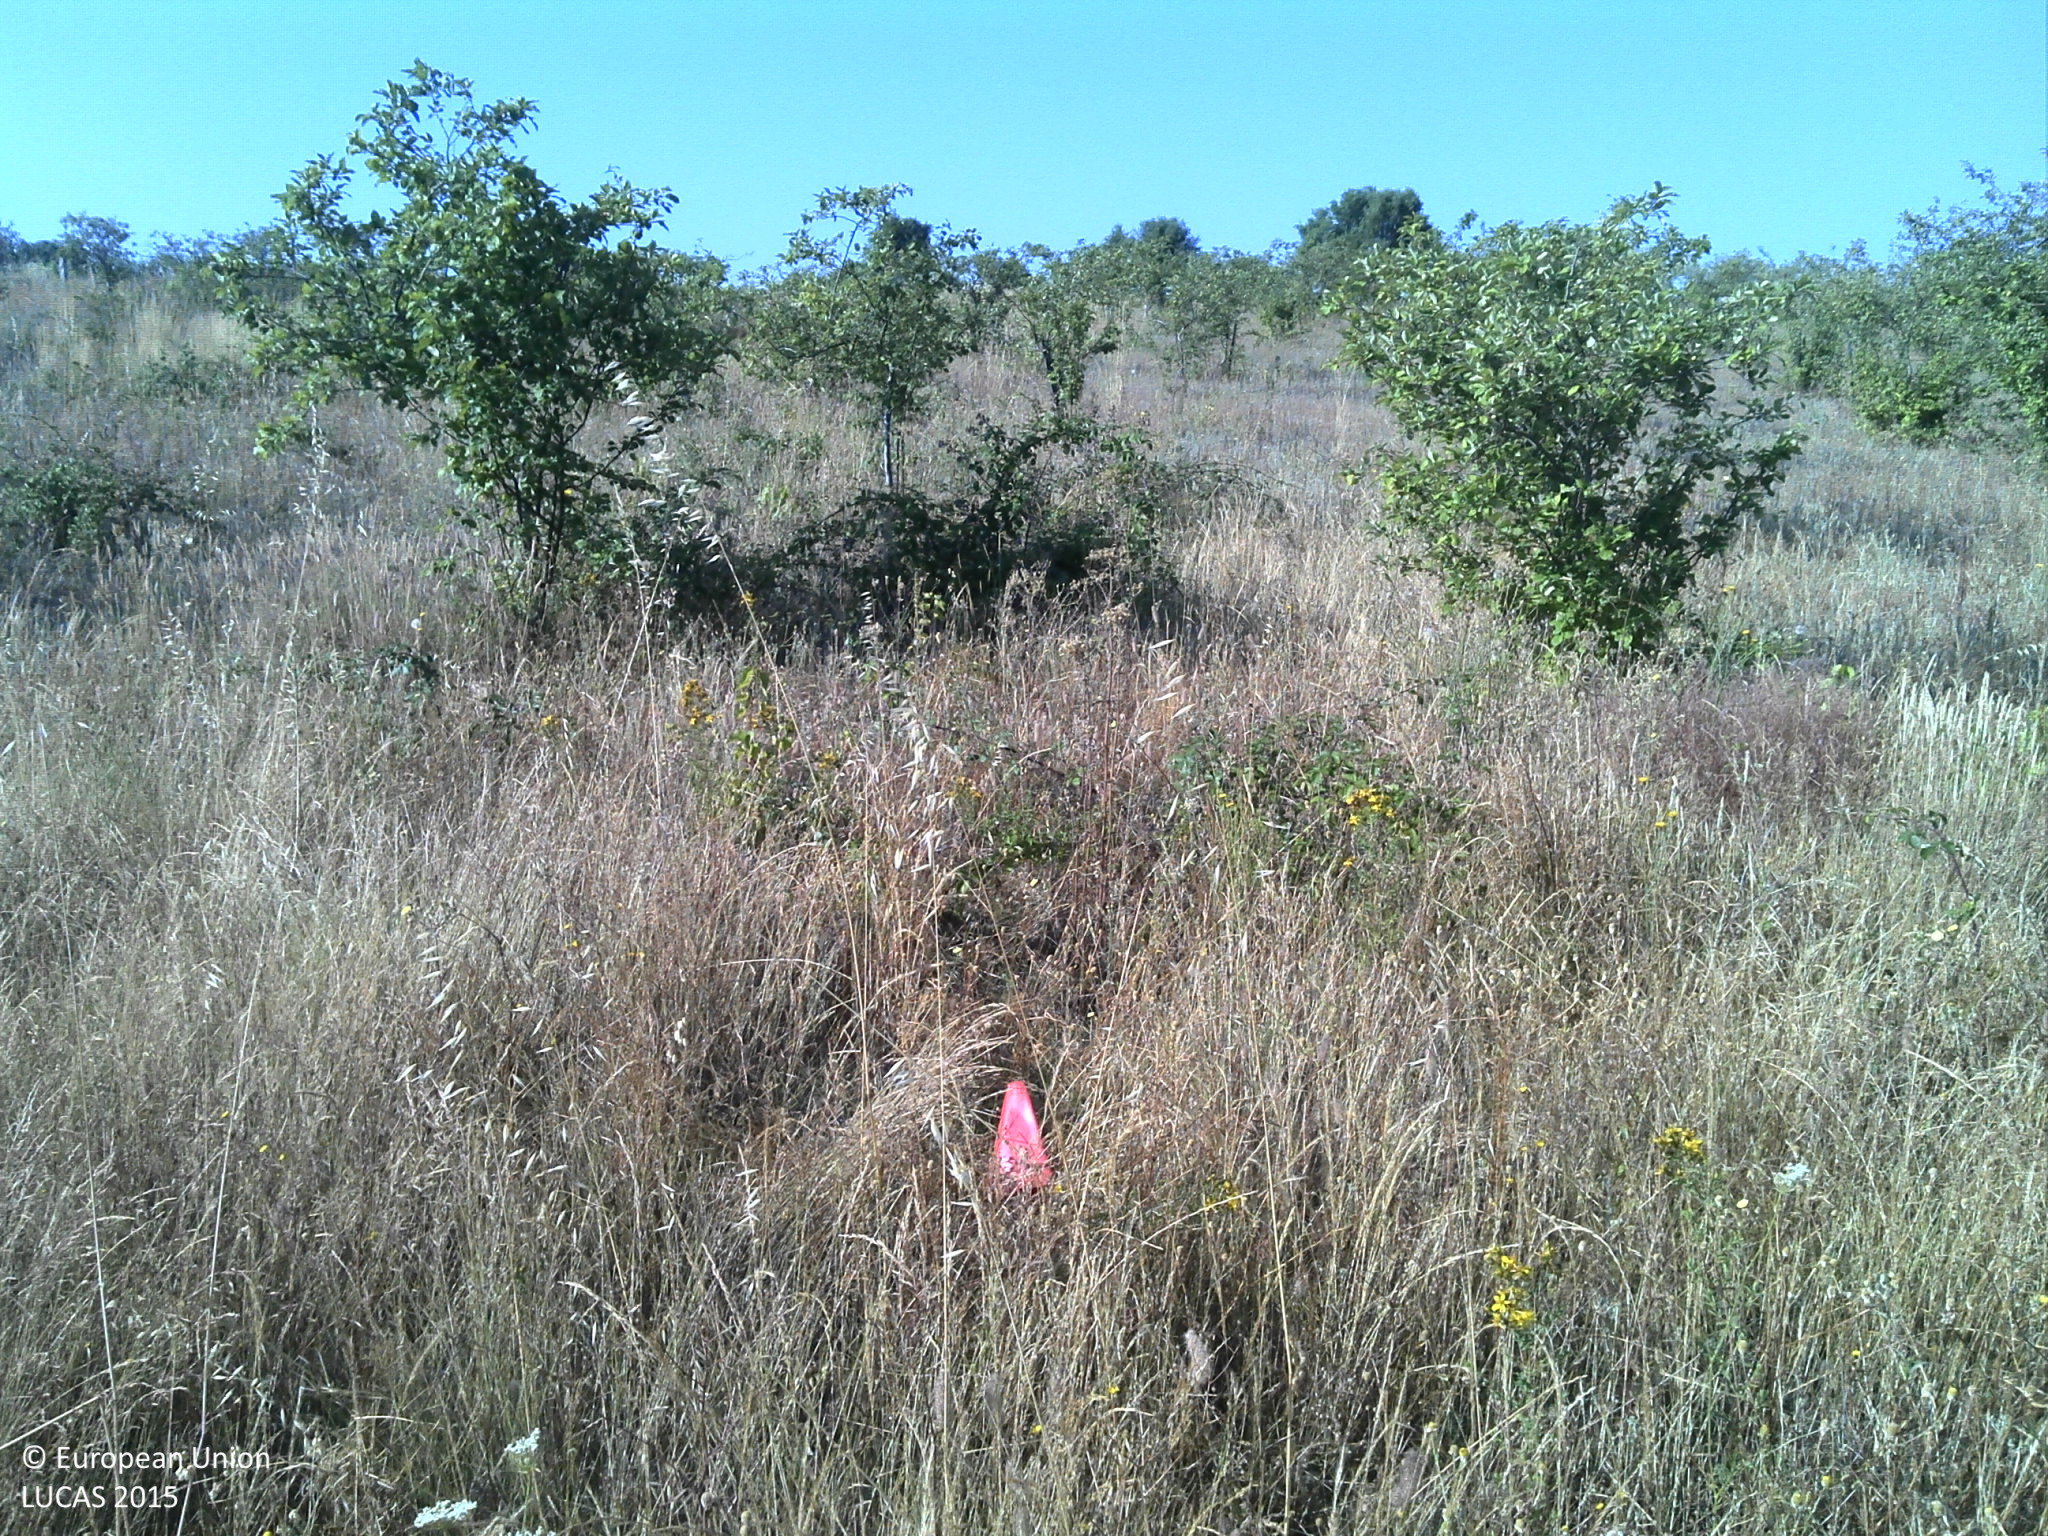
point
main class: Cropland
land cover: Other fruit trees and berries
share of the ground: 10 - 25 %
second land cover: Spontaneously vegetated surfaces
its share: 50 - 75 %
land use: Agriculture (excluding fallow land and kitchen gardens)
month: June
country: PT
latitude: 40.7746
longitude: -7.0352
